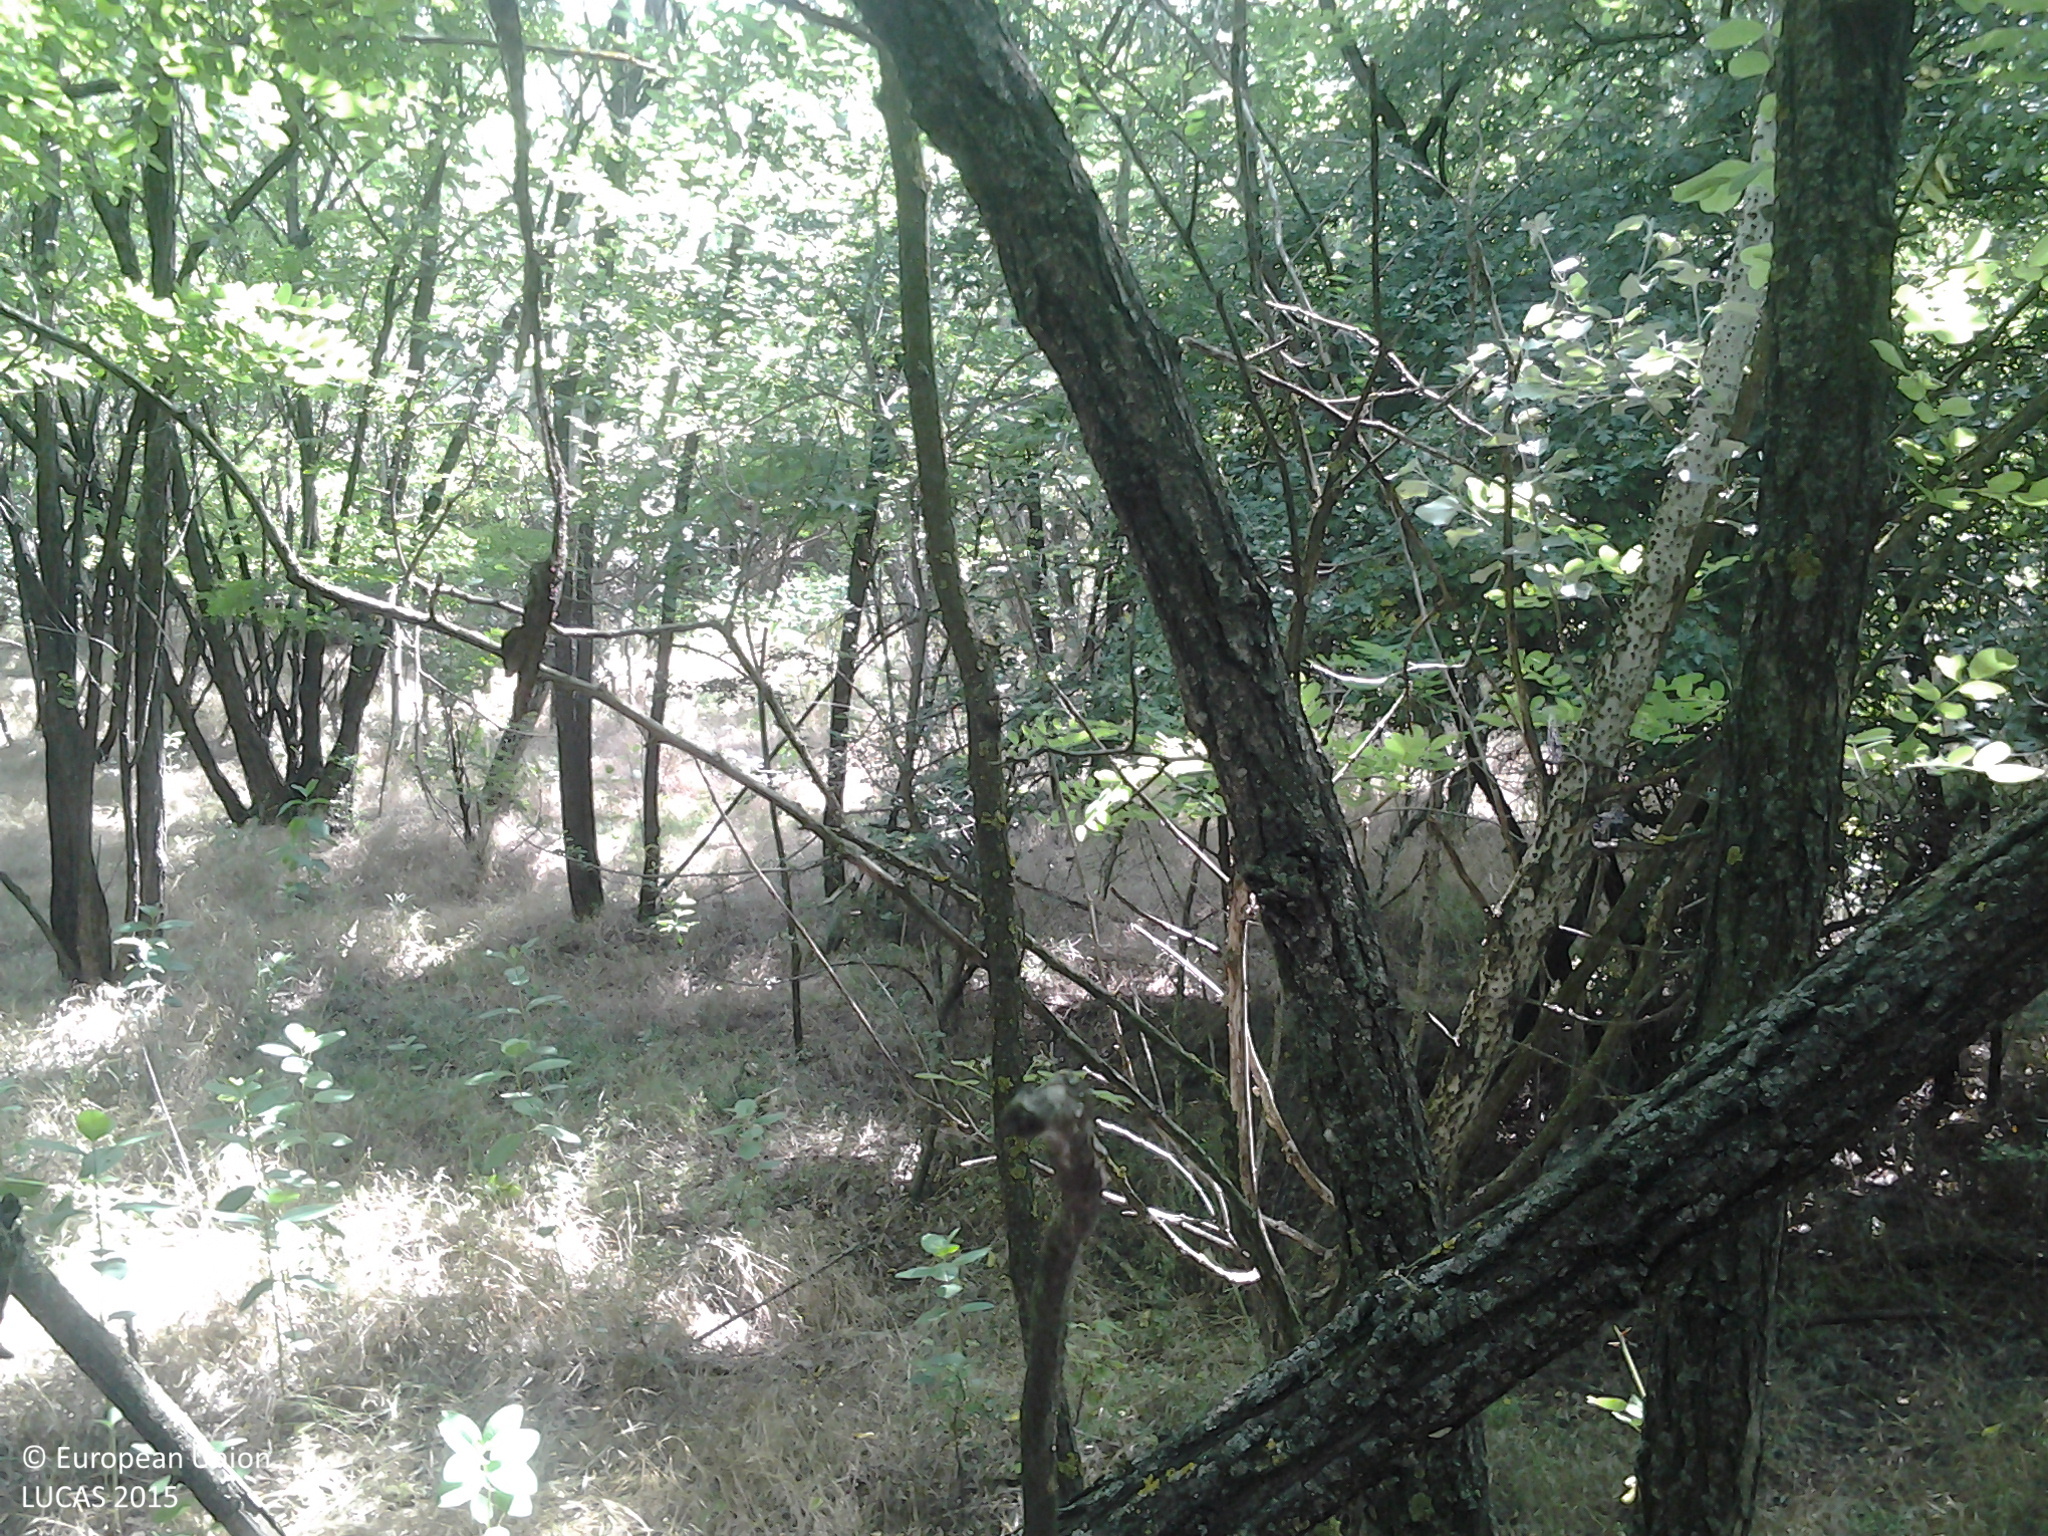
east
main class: Woodland
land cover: Broadleaved woodland
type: mesophytic deciduous forest
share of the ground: > 75 %
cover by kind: broadleaved forest trees 95 %, shrubs 5 %
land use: Forestry
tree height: > 5 m
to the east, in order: Broadleaved woodland; Grassland without tree/shrub cover; Fences; Other fruit trees and berries; Artificial constructions in urban areas
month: June
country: HU
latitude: 46.8047
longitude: 19.6246
